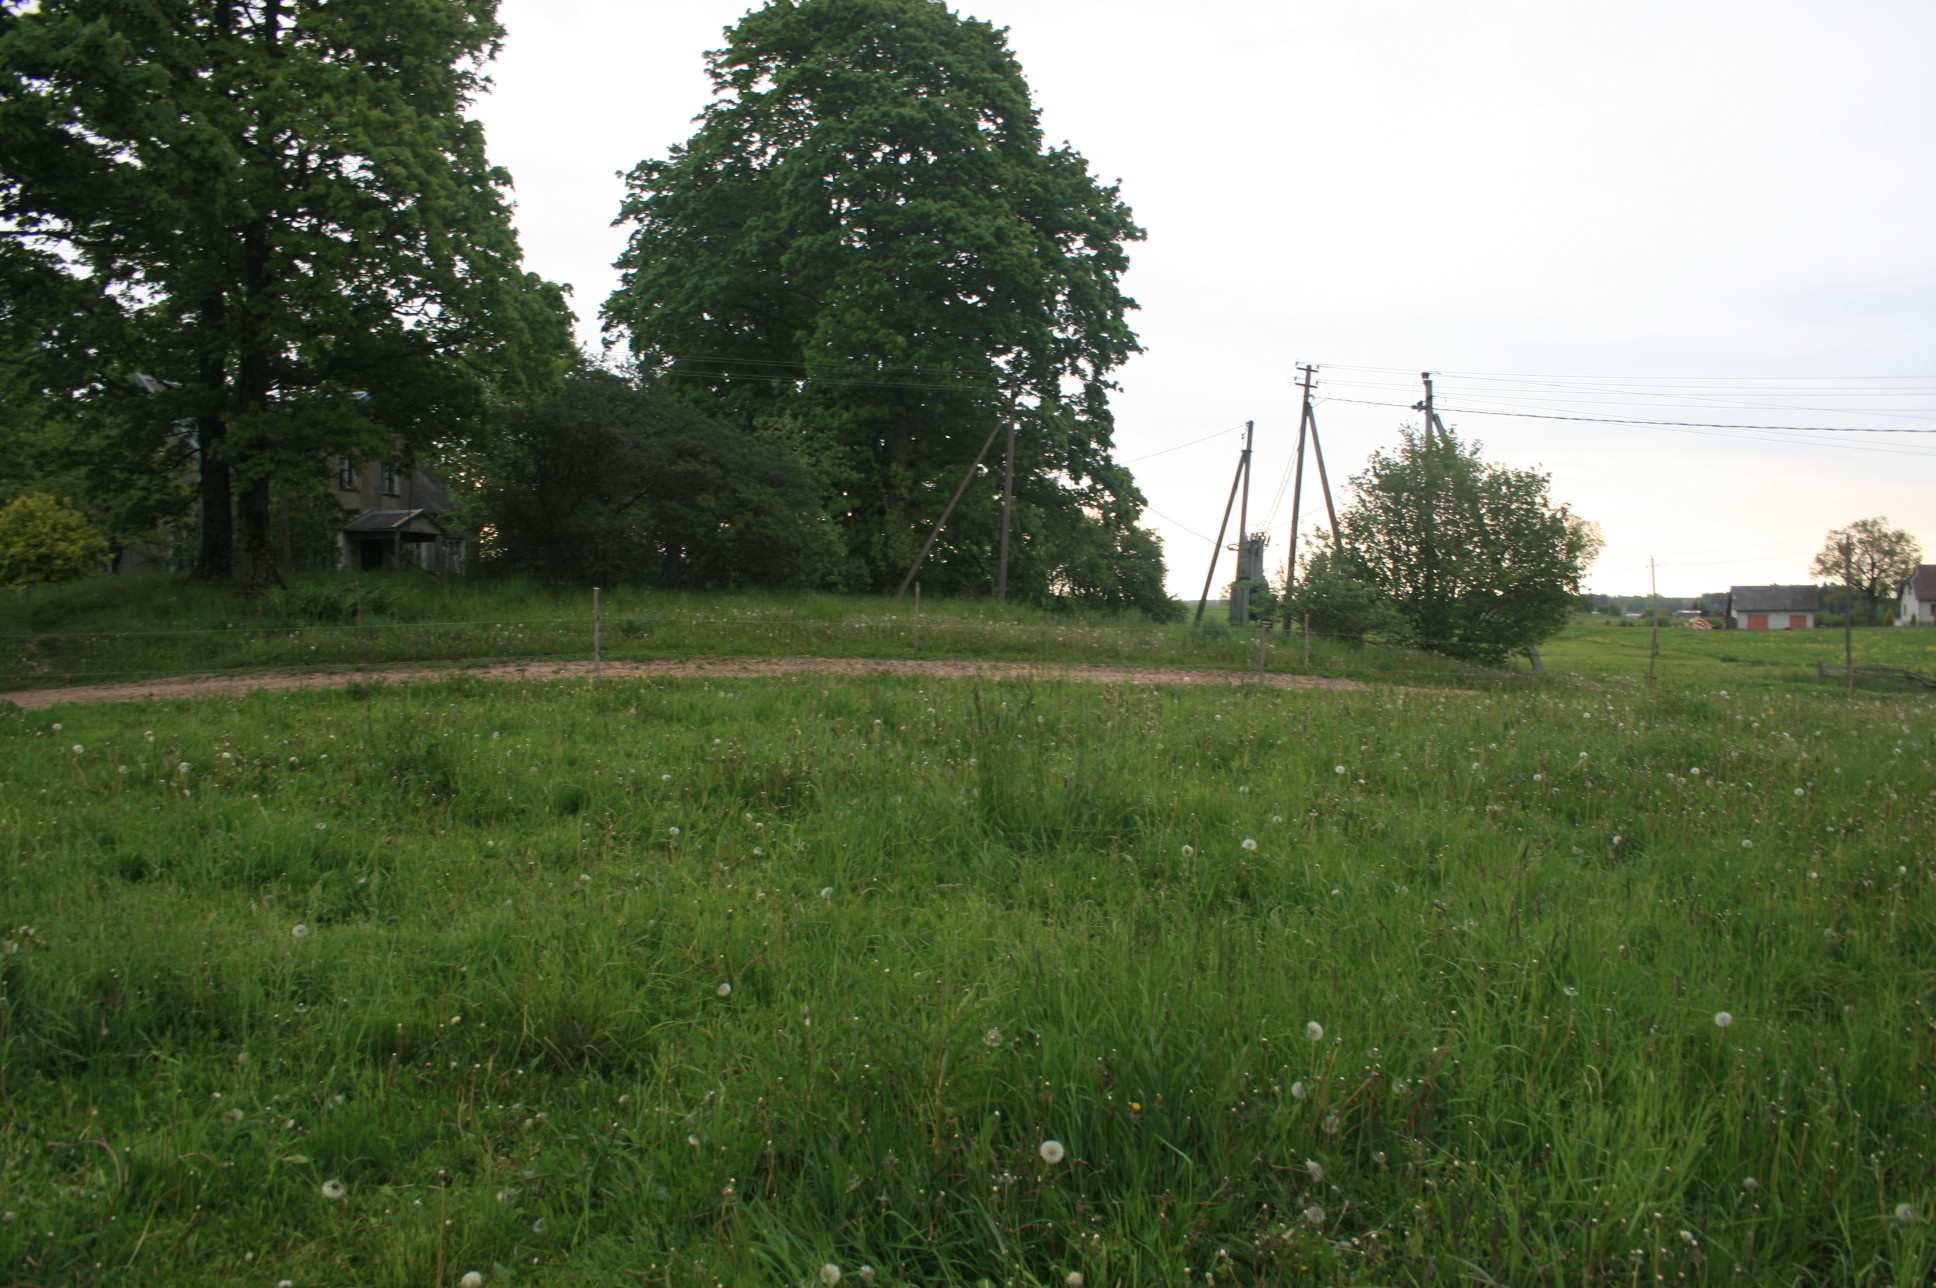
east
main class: Grassland
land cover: Grassland without tree/shrub cover
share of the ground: > 75 %
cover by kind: herbaceous plants 100 %
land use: Agriculture (excluding fallow land and kitchen gardens)
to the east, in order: Grassland without tree/shrub cover; Tracks; Grass margins; Fences; Grassland without tree/shrub cover; Electric lines; Broadleaved woodland; Artificial constructions in urban areas; Other bare soil; Fences; Grassland without tree/shrub cover; Fences; Grassland without tree/shrub cover
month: May
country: LT
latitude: 55.8896
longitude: 21.8657
